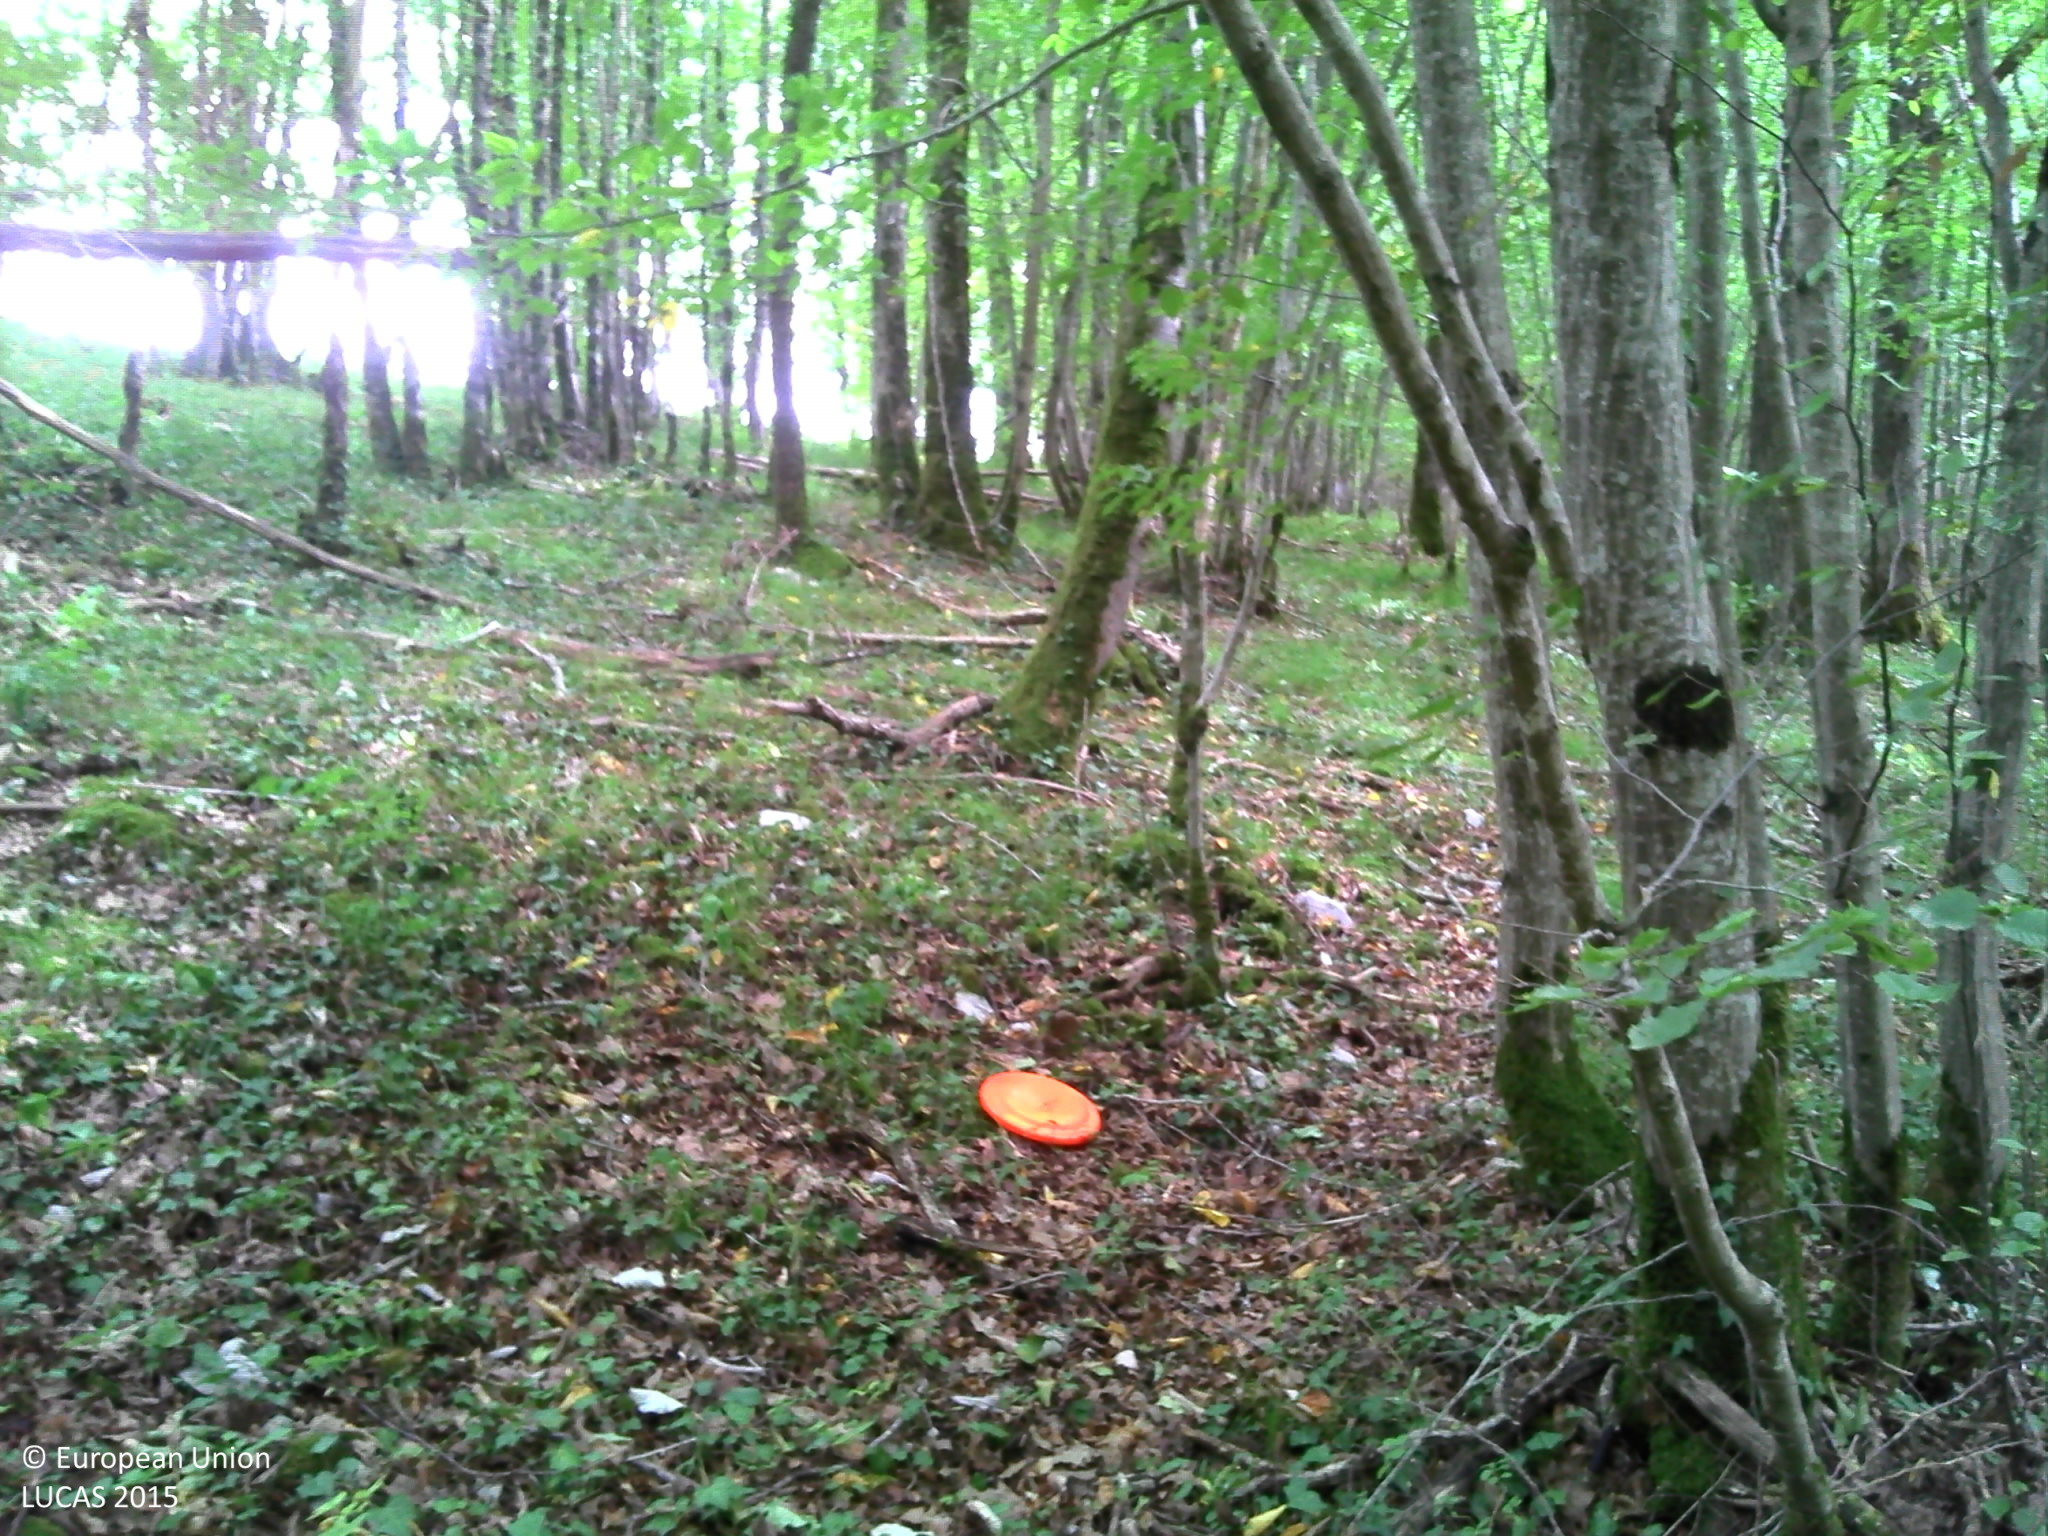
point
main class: Woodland
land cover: Broadleaved woodland
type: mesophytic deciduous forest
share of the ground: > 75 %
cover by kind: broadleaved forest trees 90 %, herbaceous plants 5 %, lichens and mosses 5 %
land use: Forestry
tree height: > 5 m
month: August
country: FR
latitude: 47.6856
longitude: 4.7904
